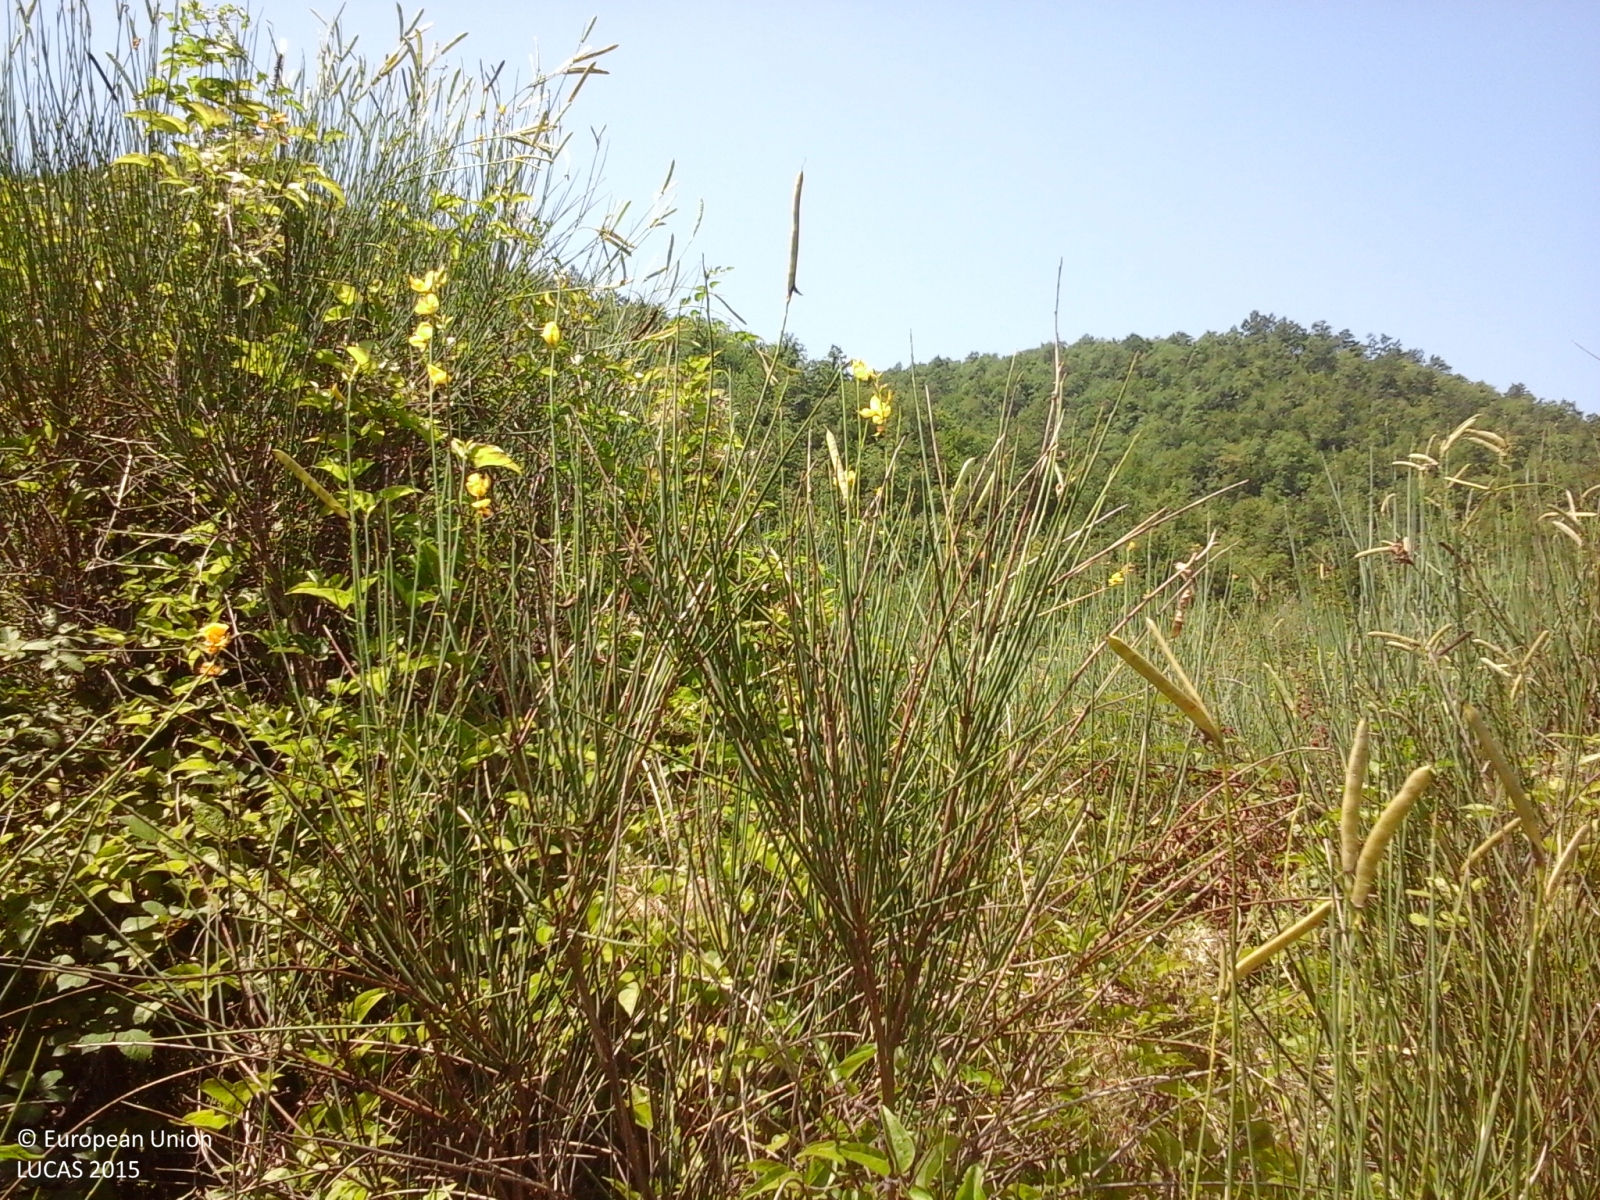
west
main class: Woodland
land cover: Broadleaved woodland
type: thermophilous deciduous forest
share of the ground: > 75 %
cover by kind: broadleaved forest trees 95 %, coniferous forest trees 5 %
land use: Forestry
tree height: > 5 m
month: August
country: IT
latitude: 43.3259
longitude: 13.2103
